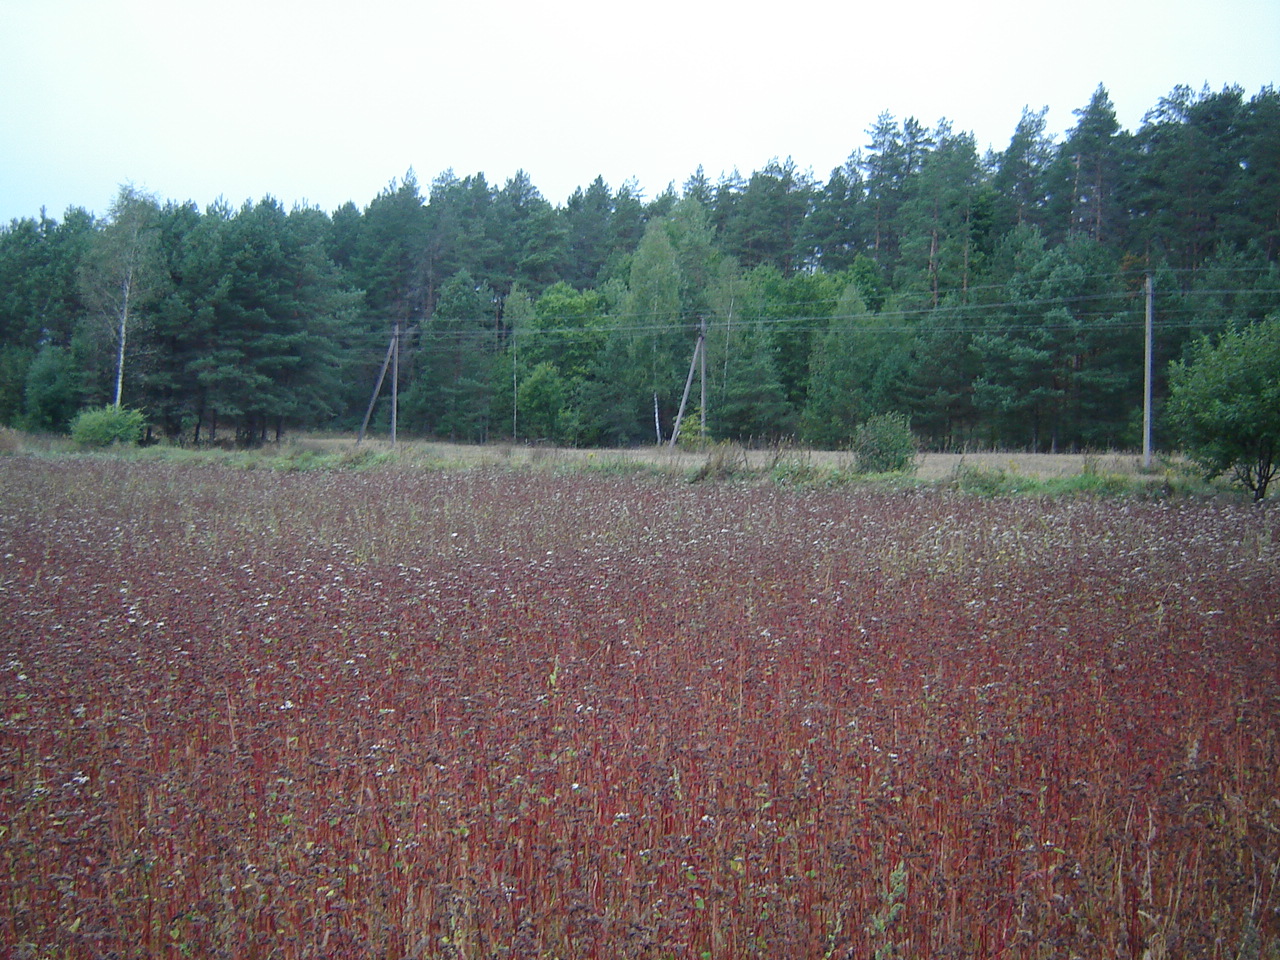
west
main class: Cropland
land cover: Other cereals
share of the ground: > 75 %
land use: Agriculture (excluding fallow land and kitchen gardens)
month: September
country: LT
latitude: 54.2955
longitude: 24.8148
